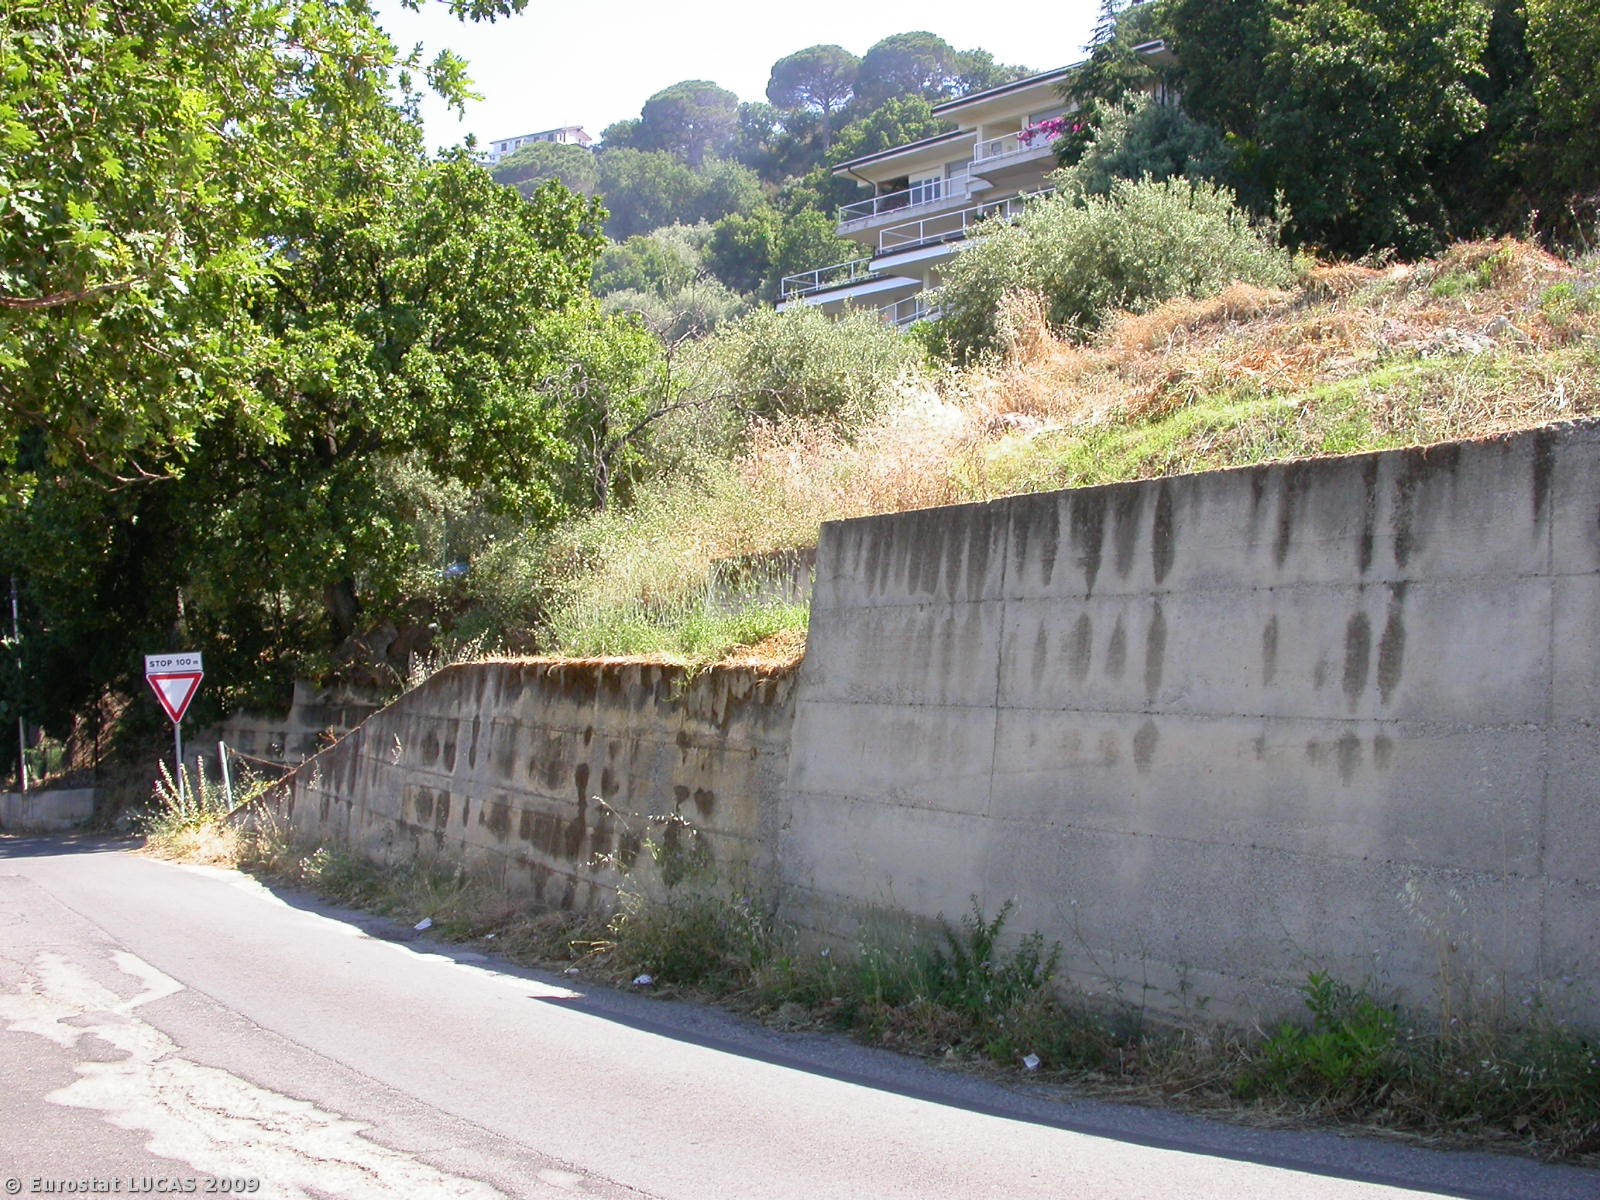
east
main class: Cropland
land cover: Olive groves
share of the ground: 50 - 75 %
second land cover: Spontaneously vegetated surfaces
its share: 25 - 50 %
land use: Agriculture (excluding fallow land and kitchen gardens)
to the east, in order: Olive groves; Spontaneously vegetated surfaces; Other citrus fruit; Spontaneously vegetated surfaces; Fences; Artificial constructions; Paved roads, cycling and walking lanes; Artificial constructions in urban areas; Intertidal flats; Transitional water bodies
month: June
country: IT
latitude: 38.1636
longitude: 14.9554
